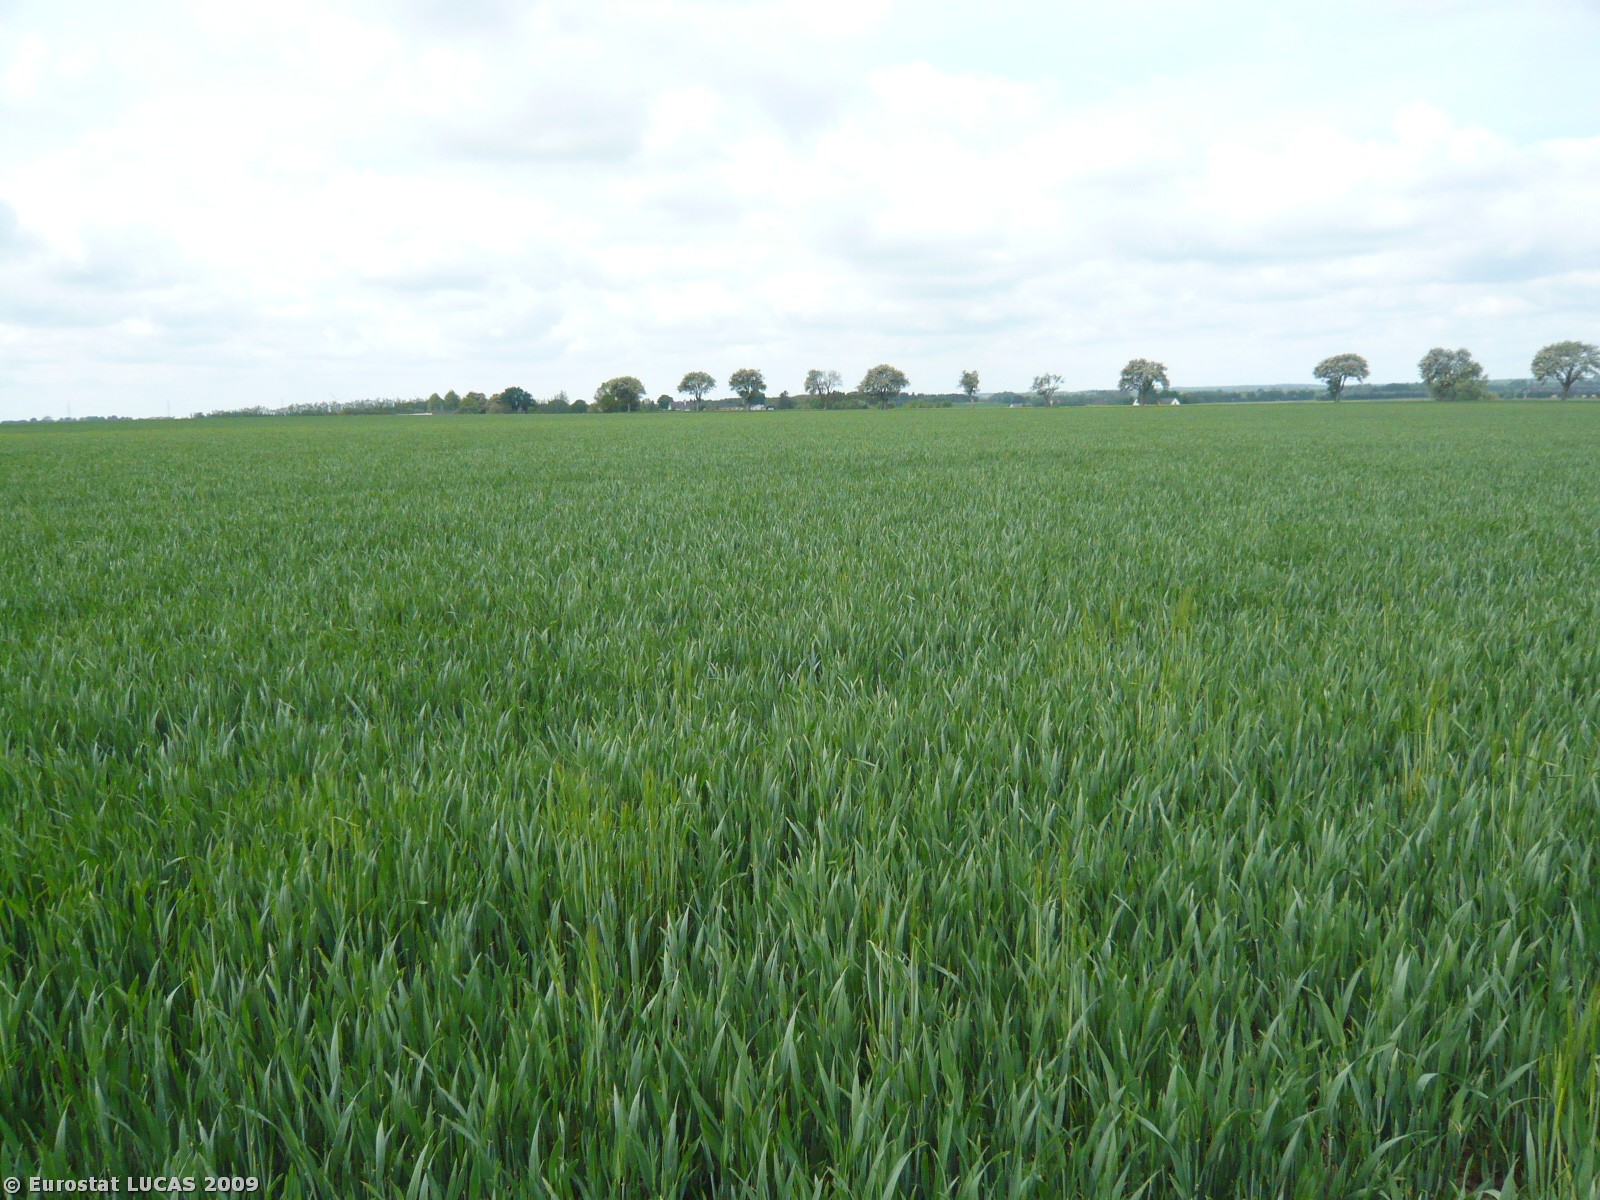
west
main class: Cropland
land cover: Common wheat
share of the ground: > 75 %
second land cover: Barley
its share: < 10 %
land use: Agriculture (excluding fallow land and kitchen gardens)
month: May
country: DK
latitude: 55.4741
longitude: 11.7862
